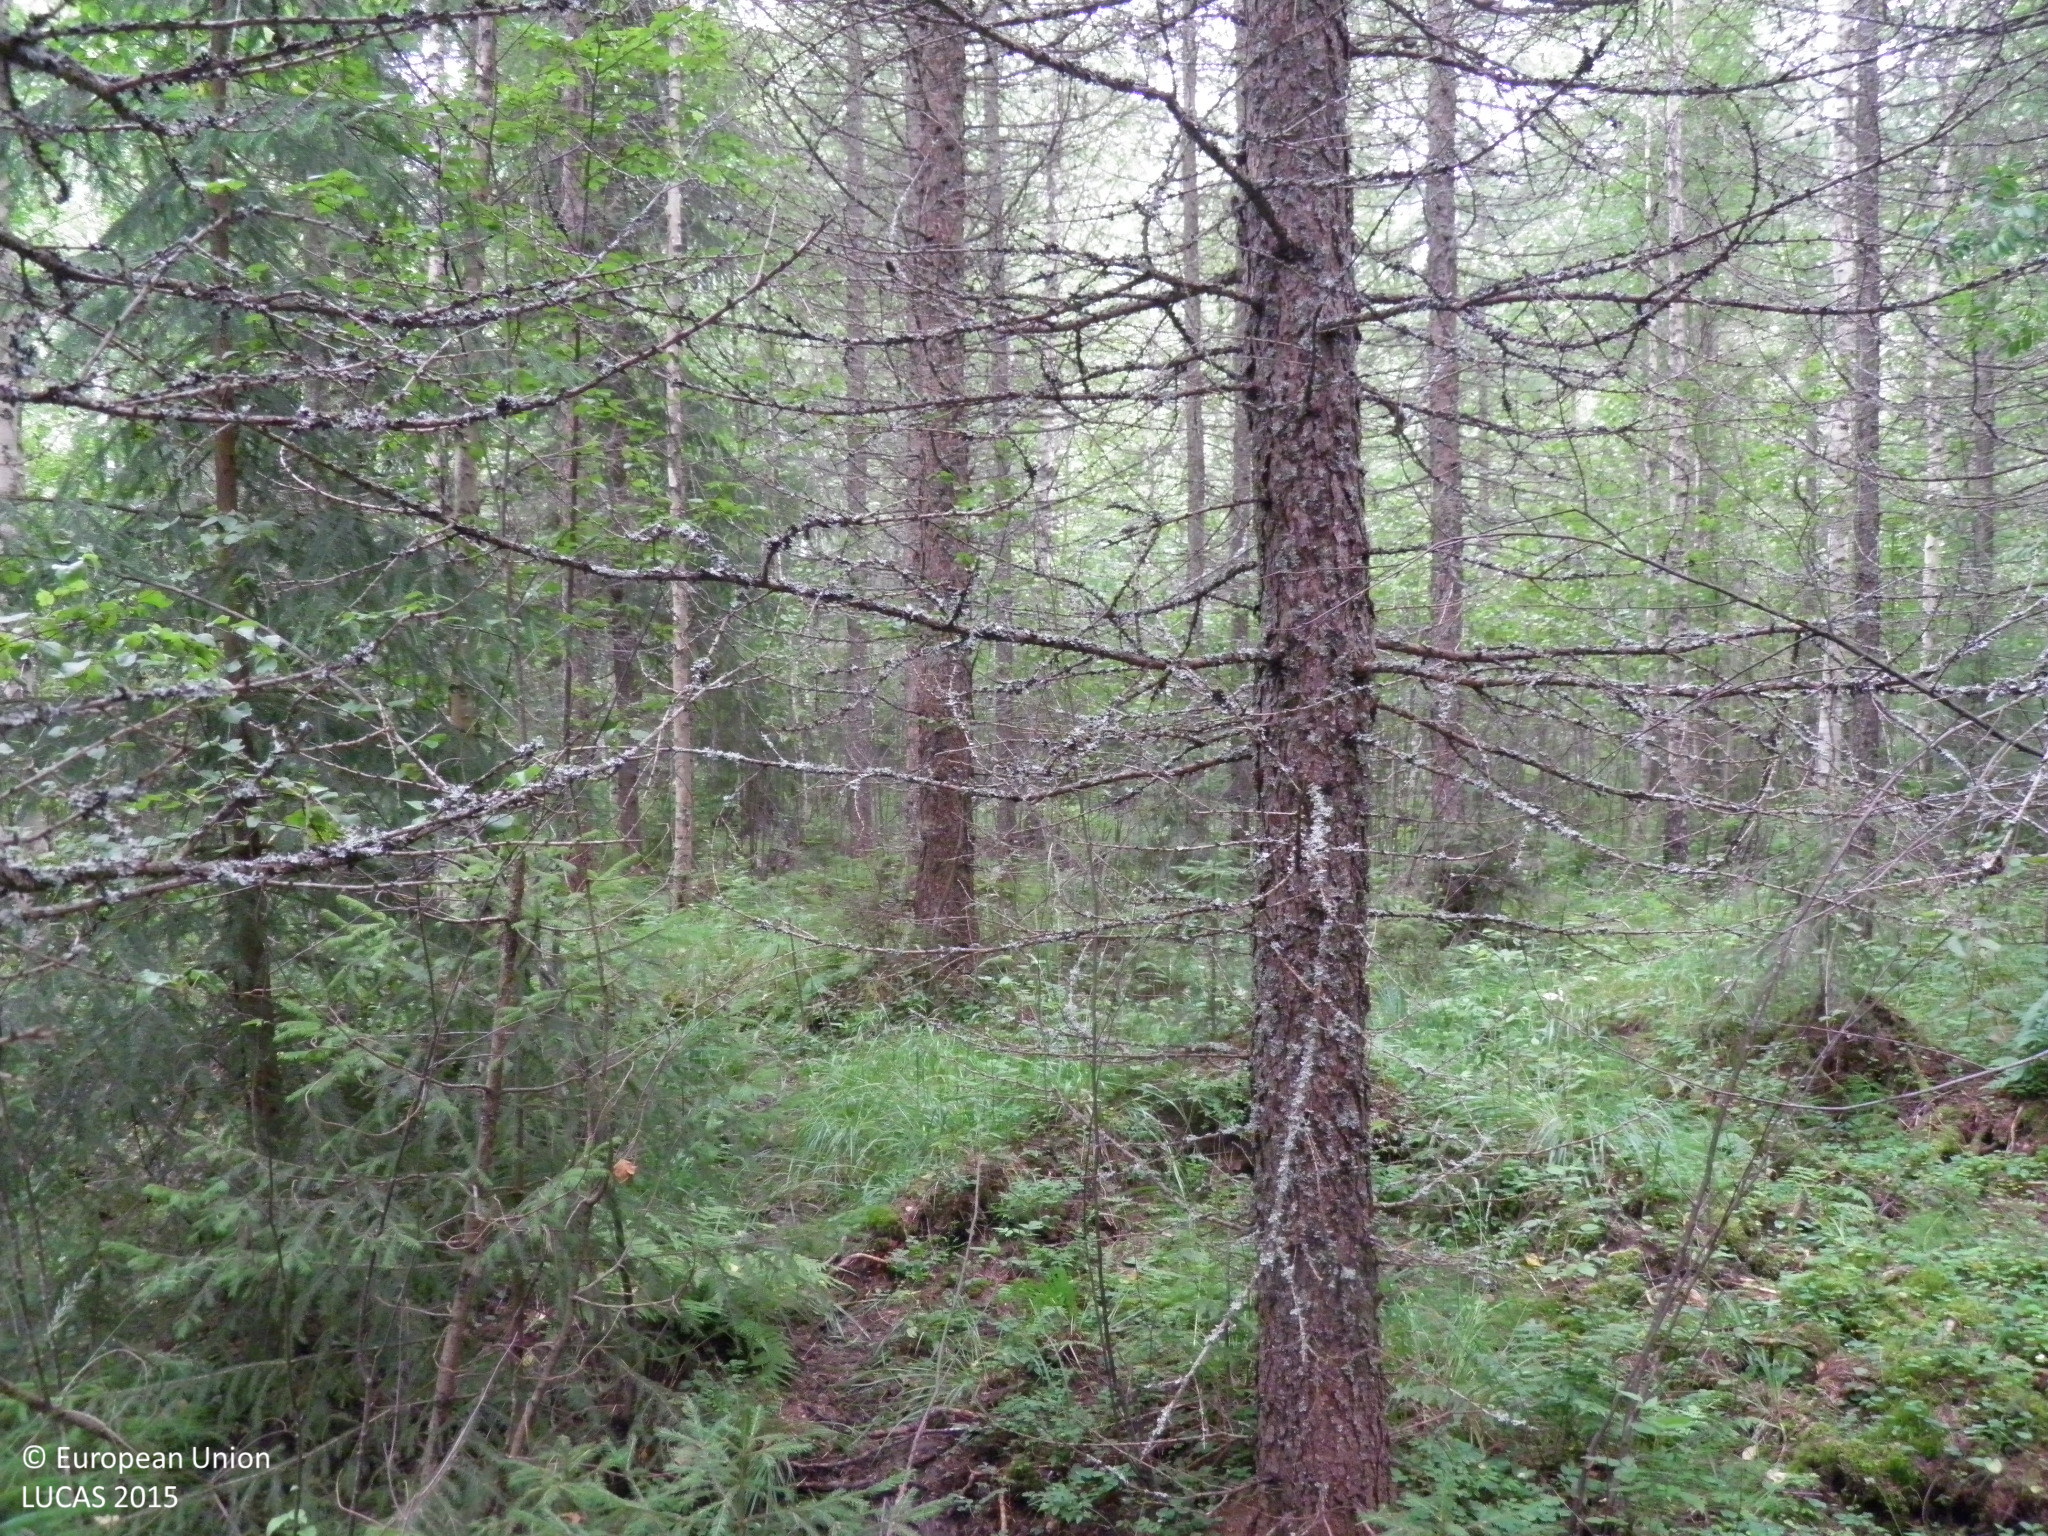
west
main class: Woodland
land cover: Pine dominated mixed woodland
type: hemiboreal forest and nemoral coniferous forest and mixed broadleaved-coniferous forest
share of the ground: > 75 %
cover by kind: broadleaved forest trees 45 %, coniferous forest trees 40 %, shrubs 5 %, herbaceous plants 5 %, lichens and mosses 5 %
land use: Forestry
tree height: > 5 m
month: July
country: FI
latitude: 60.8642
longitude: 22.9075
